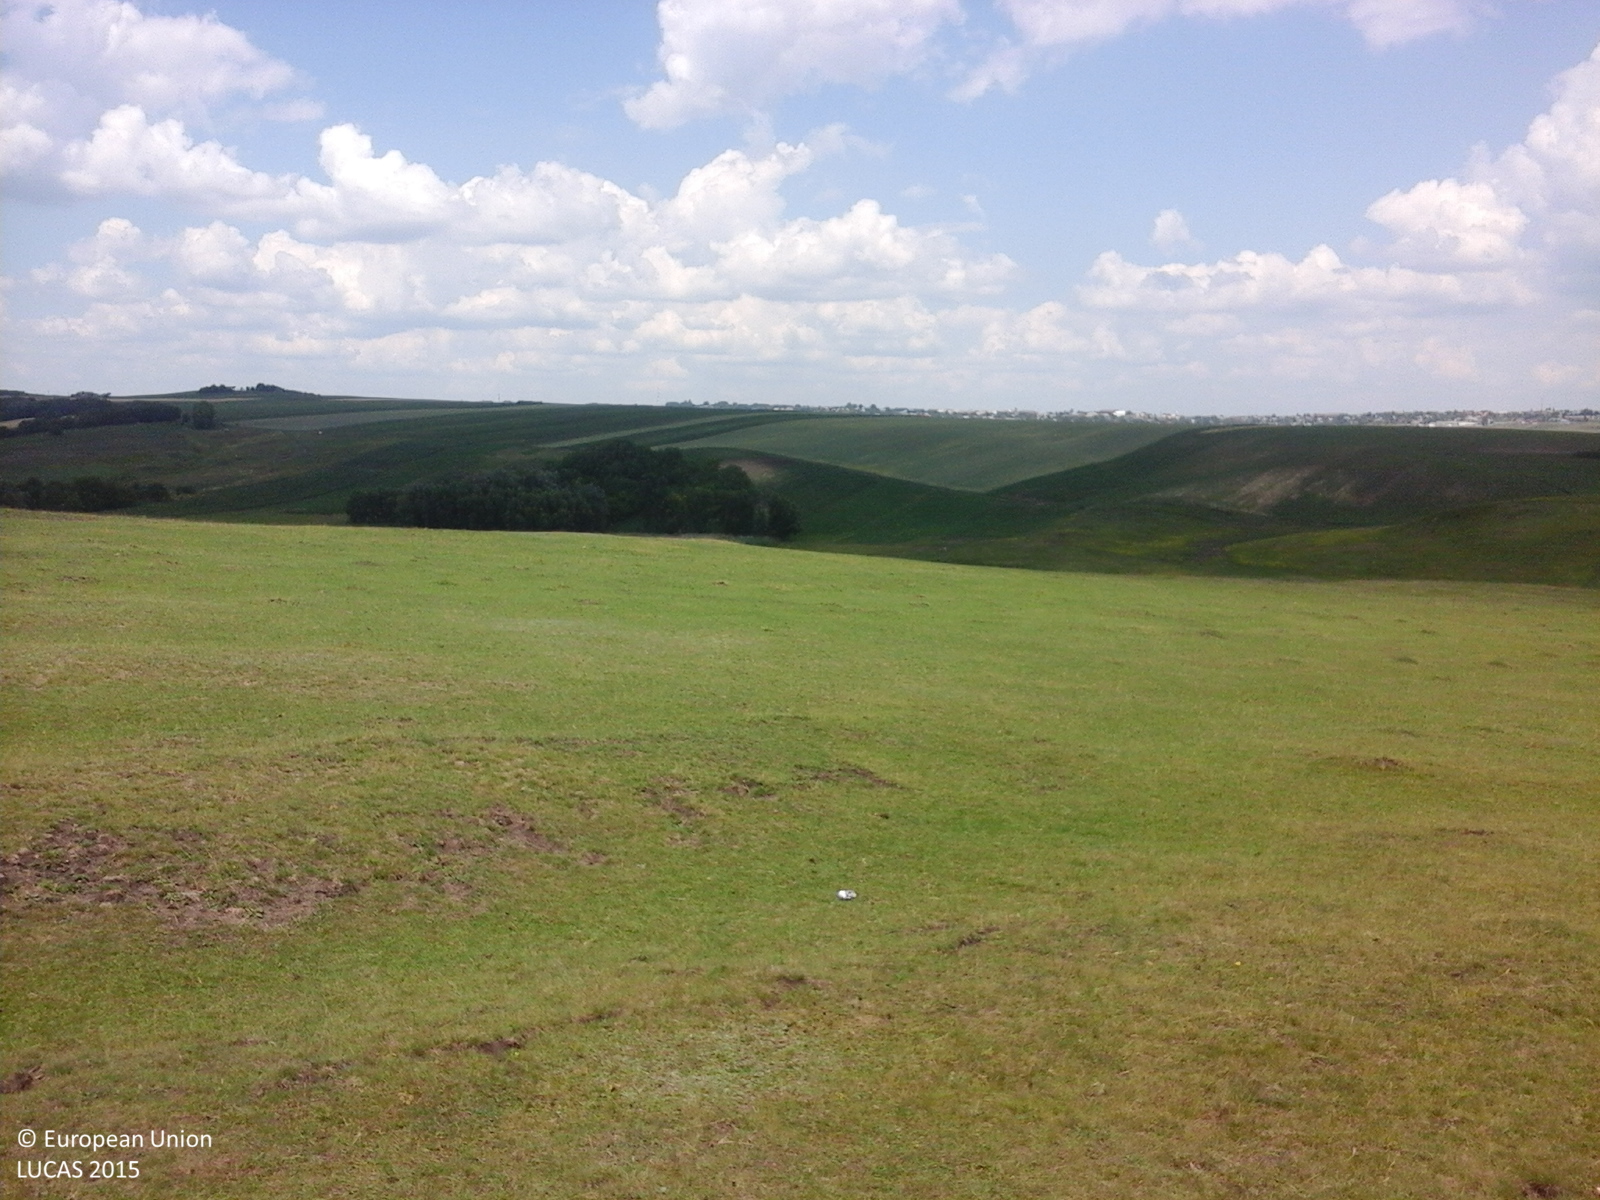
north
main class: Grassland
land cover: Grassland without tree/shrub cover
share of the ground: > 75 %
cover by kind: herbaceous plants 100 %
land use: Agriculture (excluding fallow land and kitchen gardens)
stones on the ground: < 10 %
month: June
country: RO
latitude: 48.1491
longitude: 26.5878
